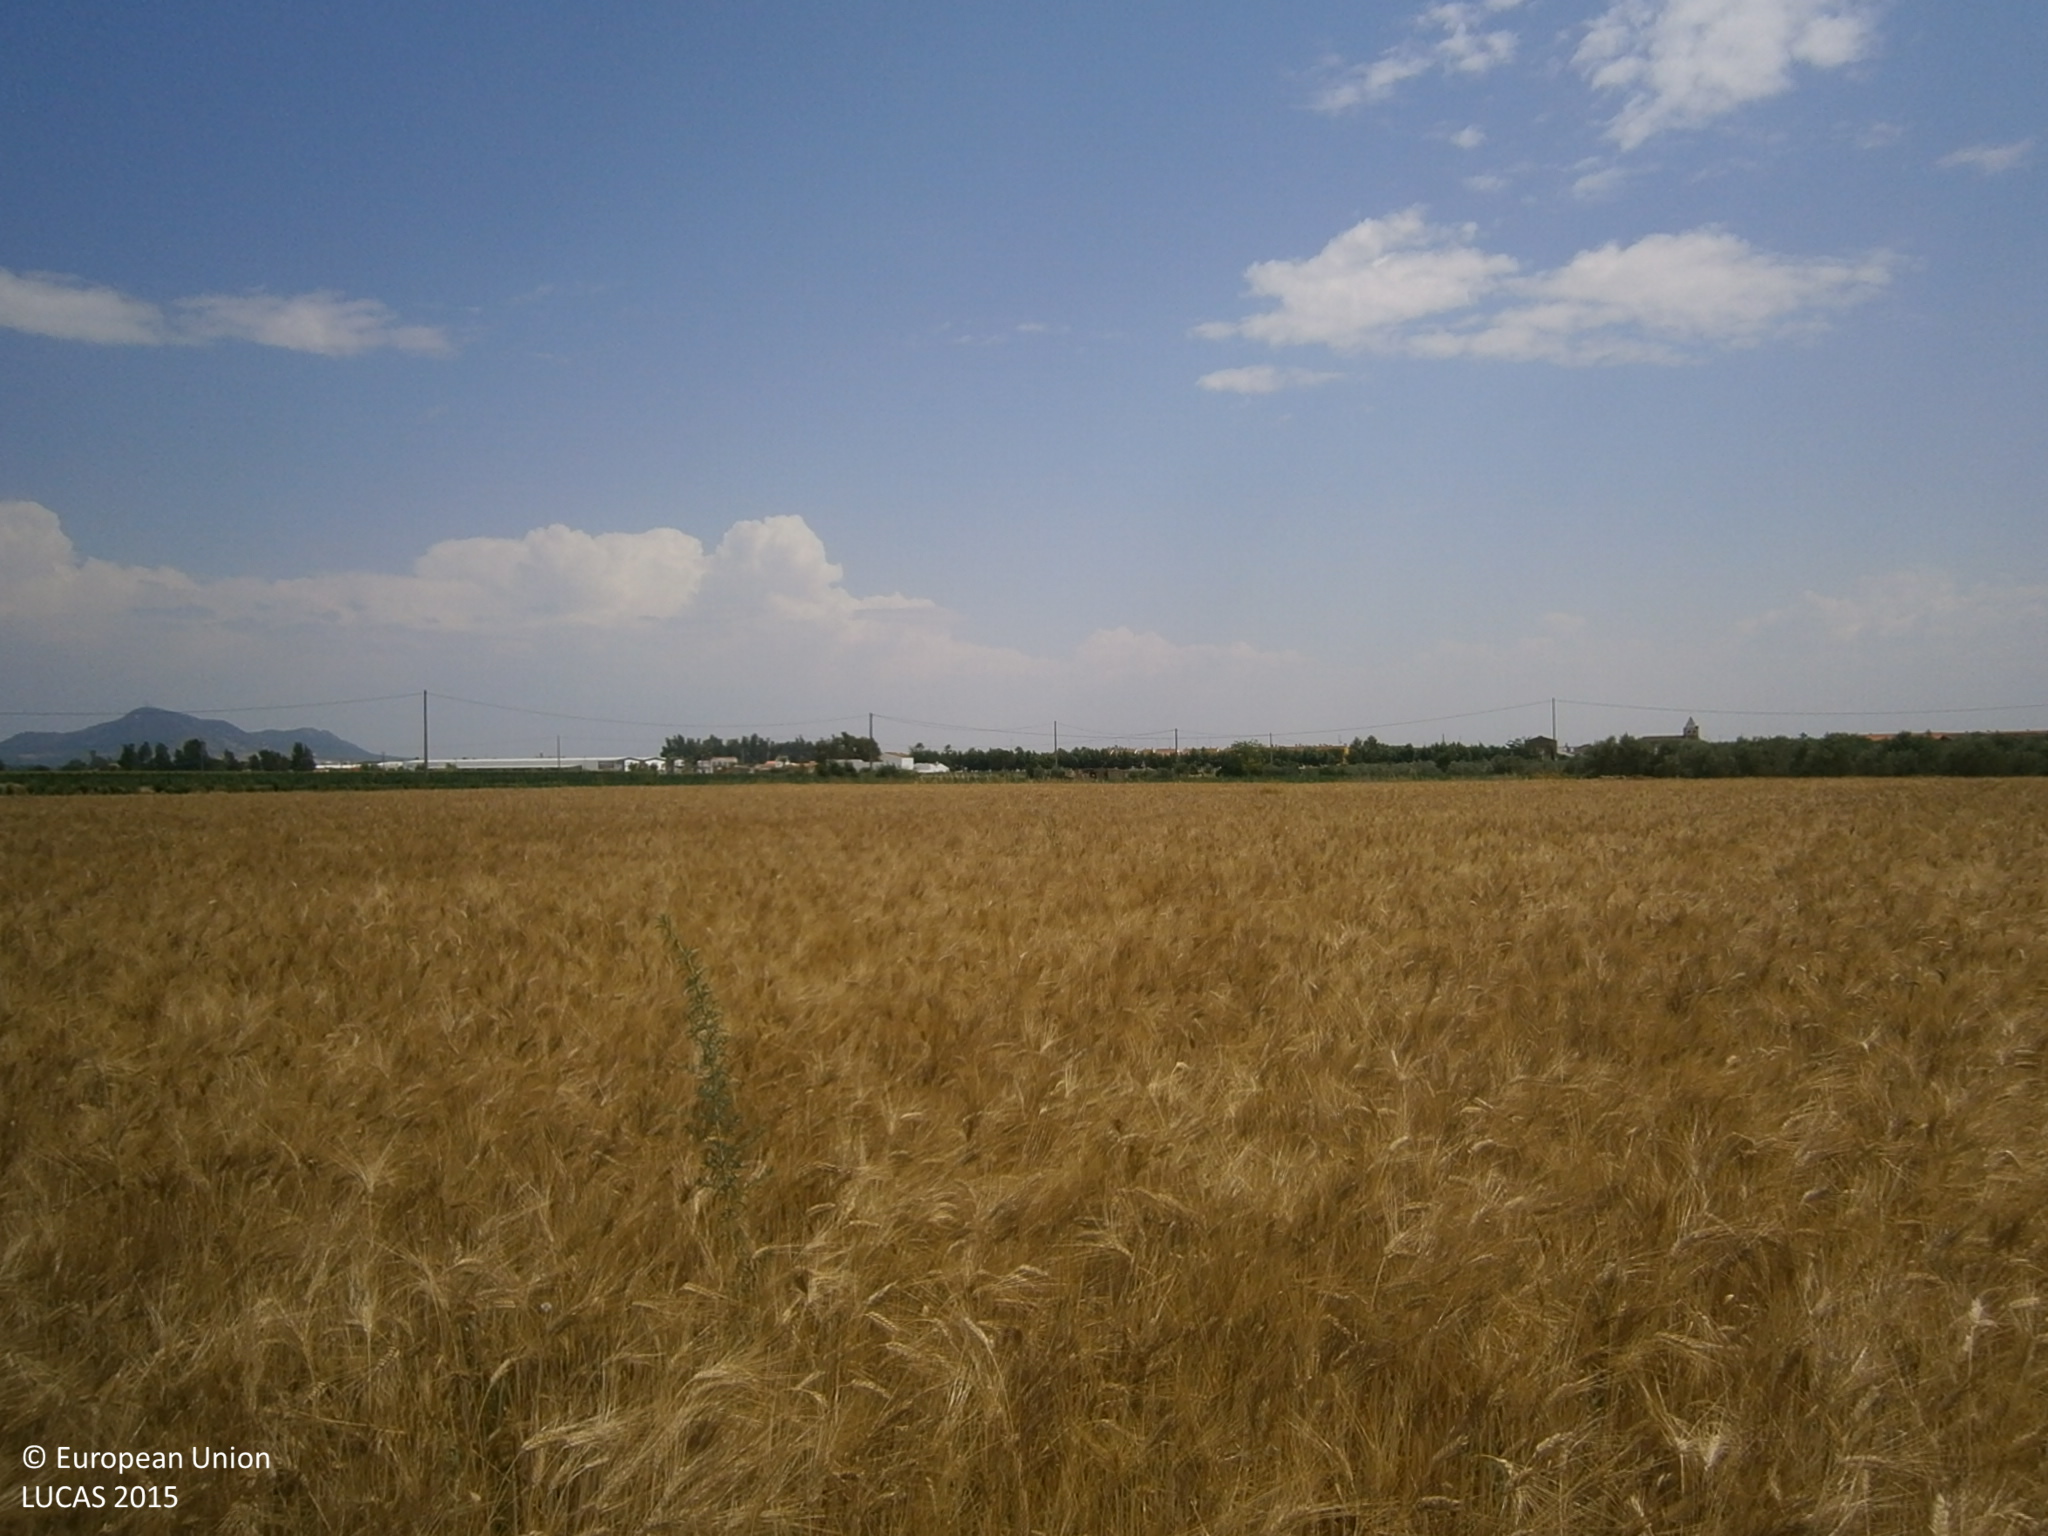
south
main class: Cropland
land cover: Durum wheat
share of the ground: > 75 %
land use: Agriculture (excluding fallow land and kitchen gardens)
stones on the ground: < 10 %
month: June
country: ES
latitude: 38.9077
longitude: -6.5403
